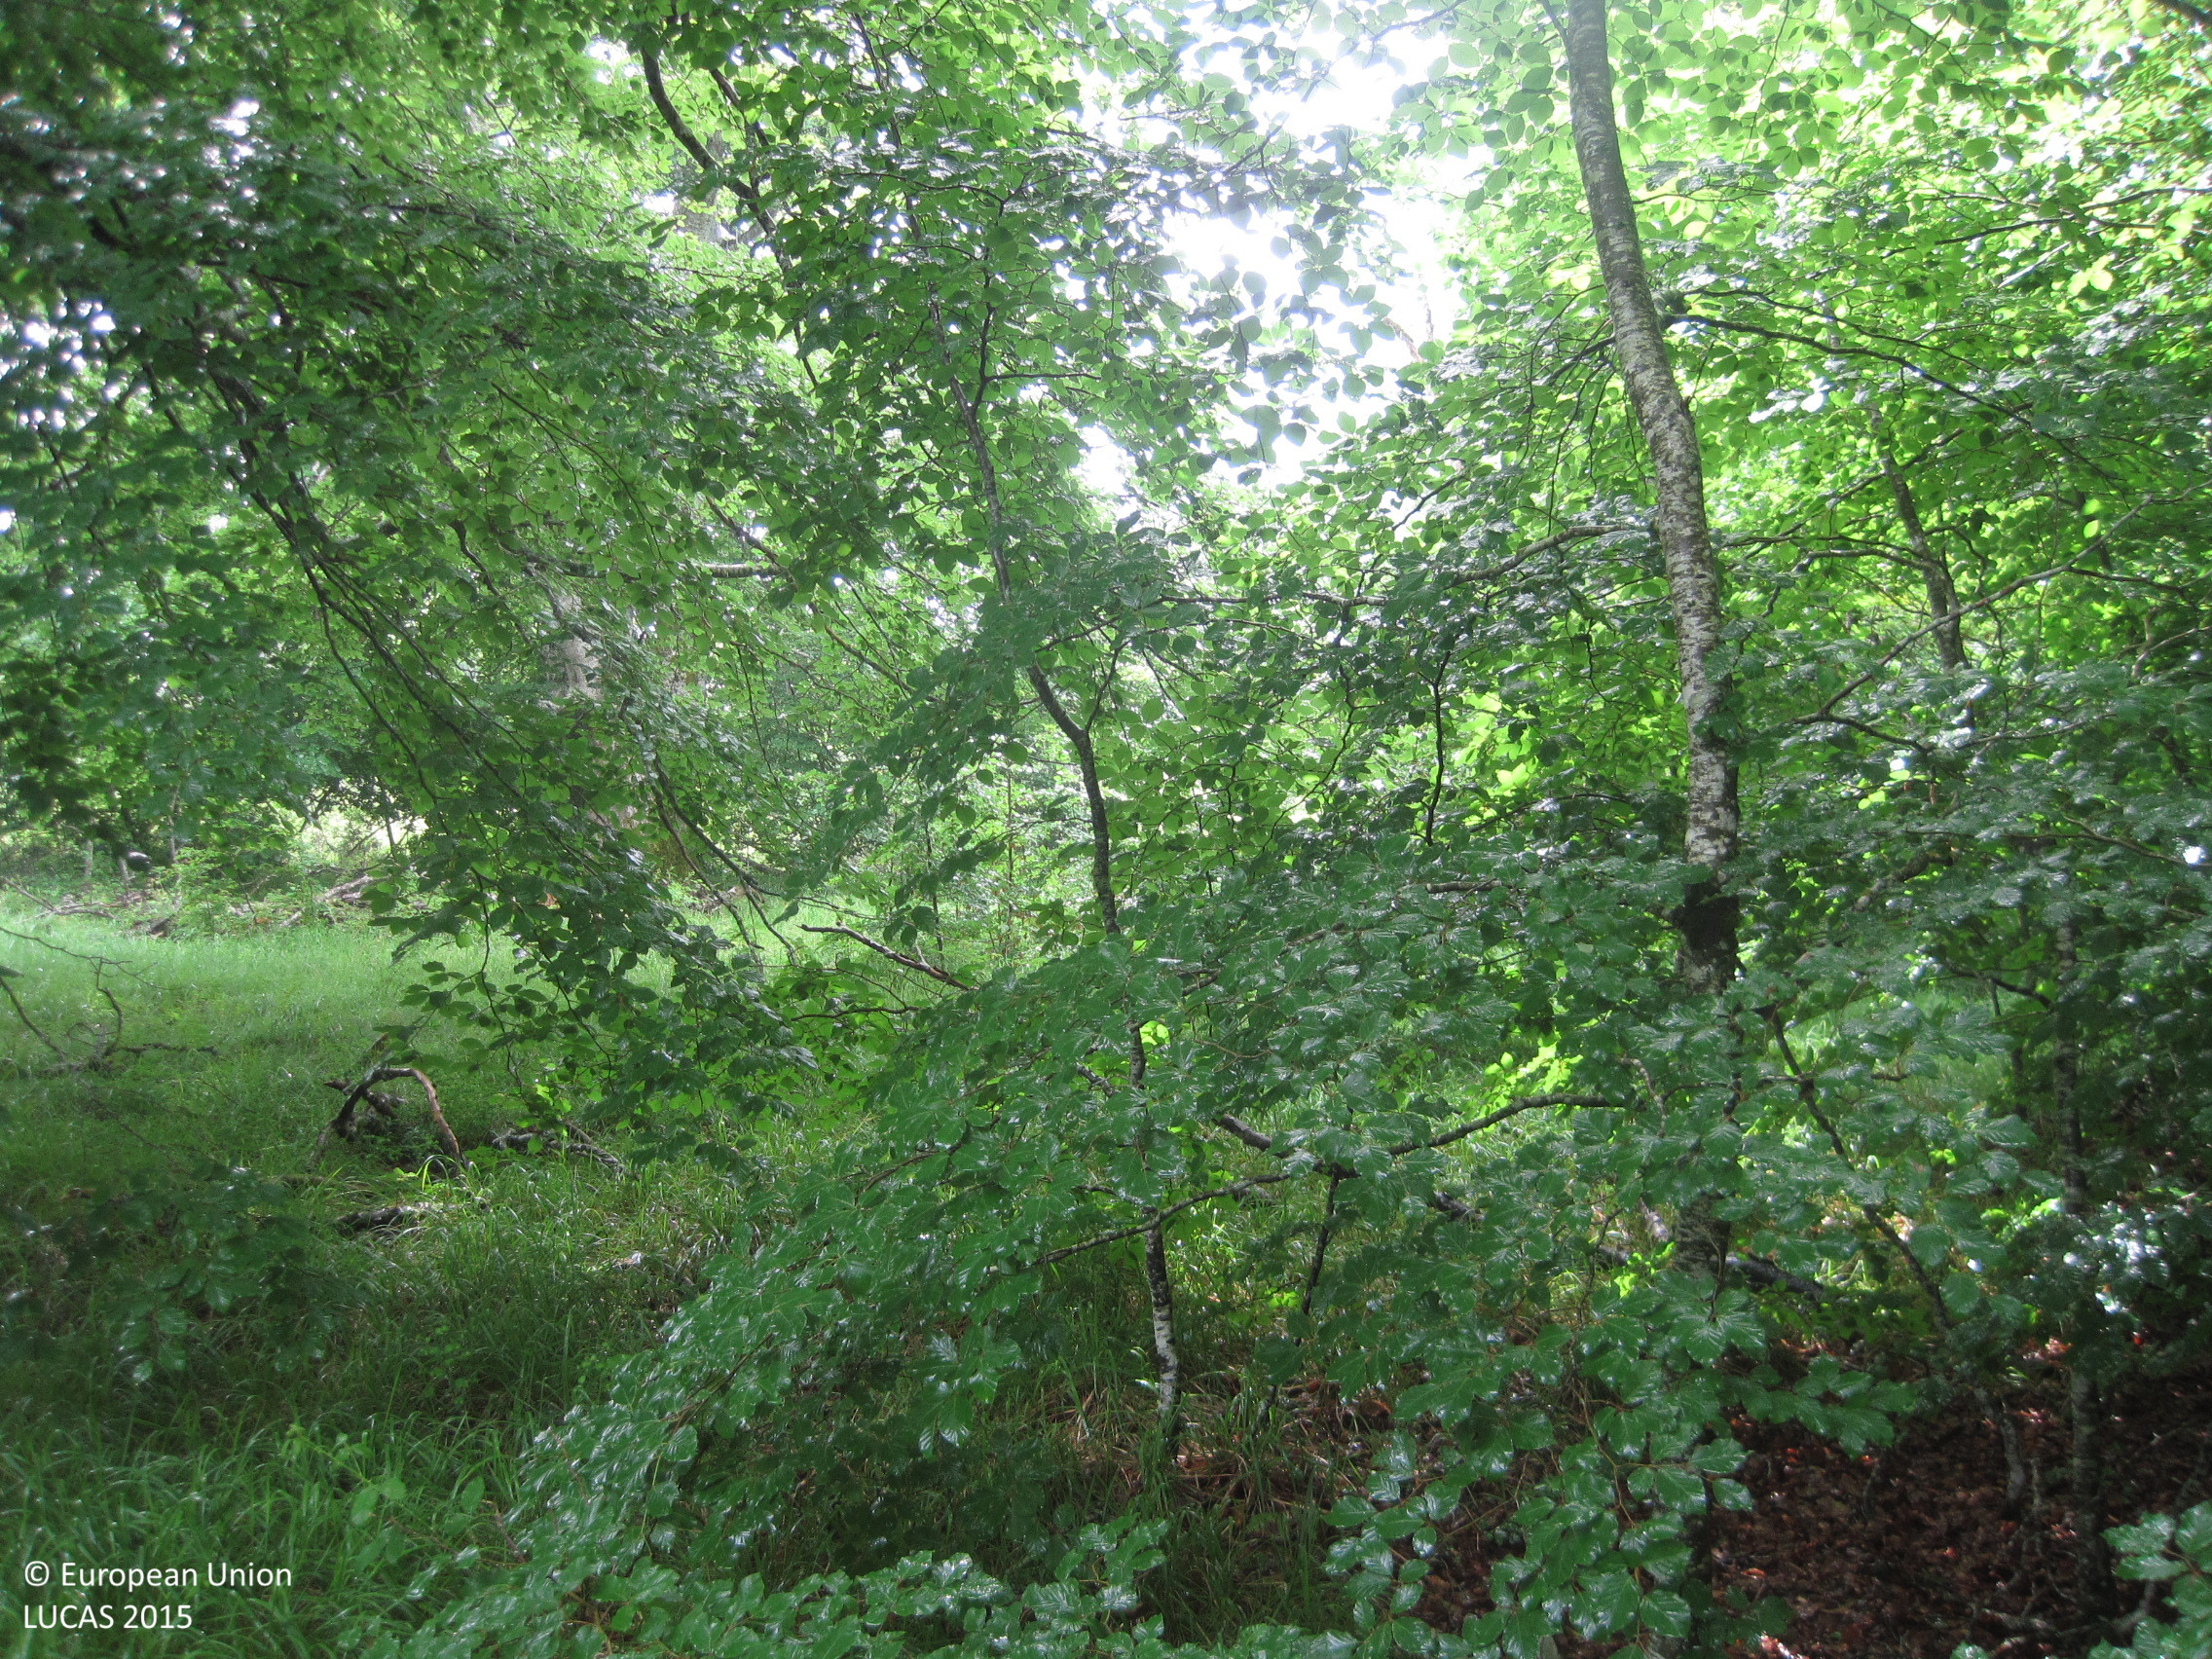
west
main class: Woodland
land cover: Broadleaved woodland
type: beech forest
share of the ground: > 75 %
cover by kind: broadleaved forest trees 95 %, herbaceous plants 5 %
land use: Forestry
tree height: > 5 m
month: June
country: ES
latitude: 42.7881
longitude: -2.2087
